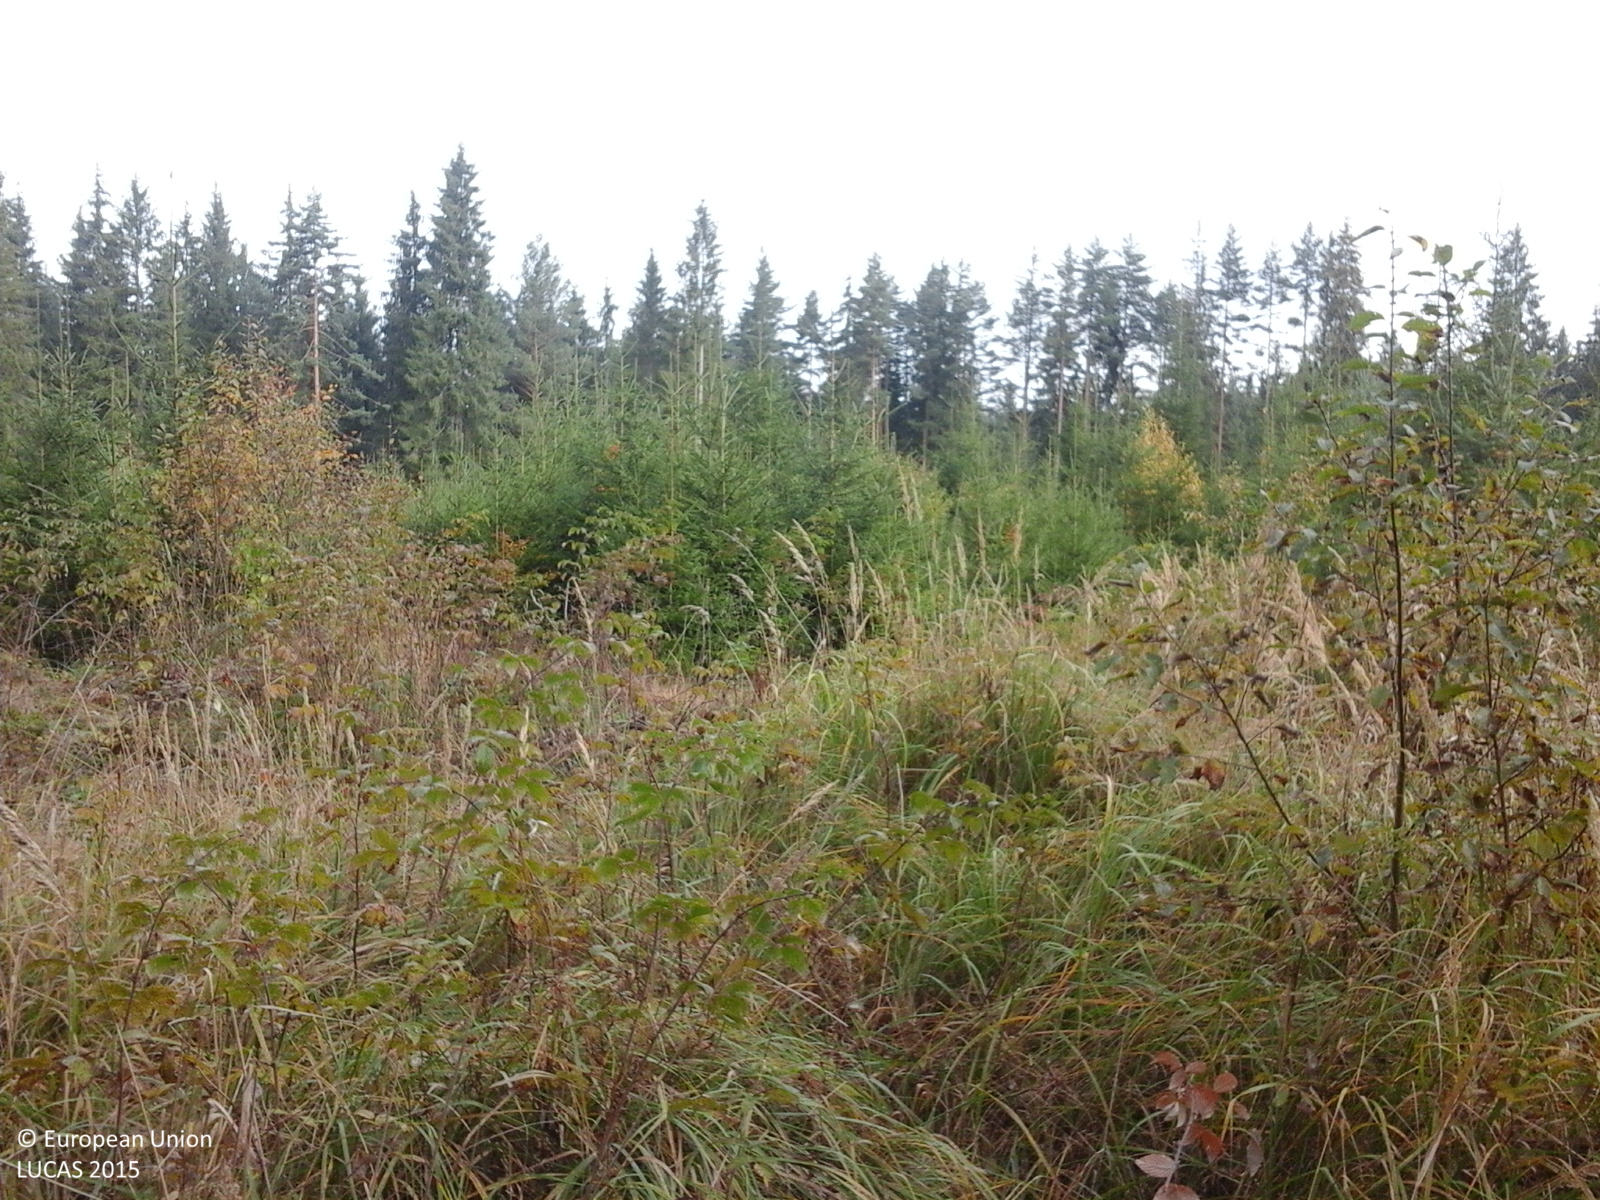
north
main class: Grassland
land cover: Grassland with sparse tree/shrub cover
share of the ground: > 75 %
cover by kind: herbaceous plants 85 %, shrubs 10 %, broadleaved forest trees 5 %
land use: Fallow land
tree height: < 5 m
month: October
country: RO
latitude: 46.4796
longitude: 25.3581
